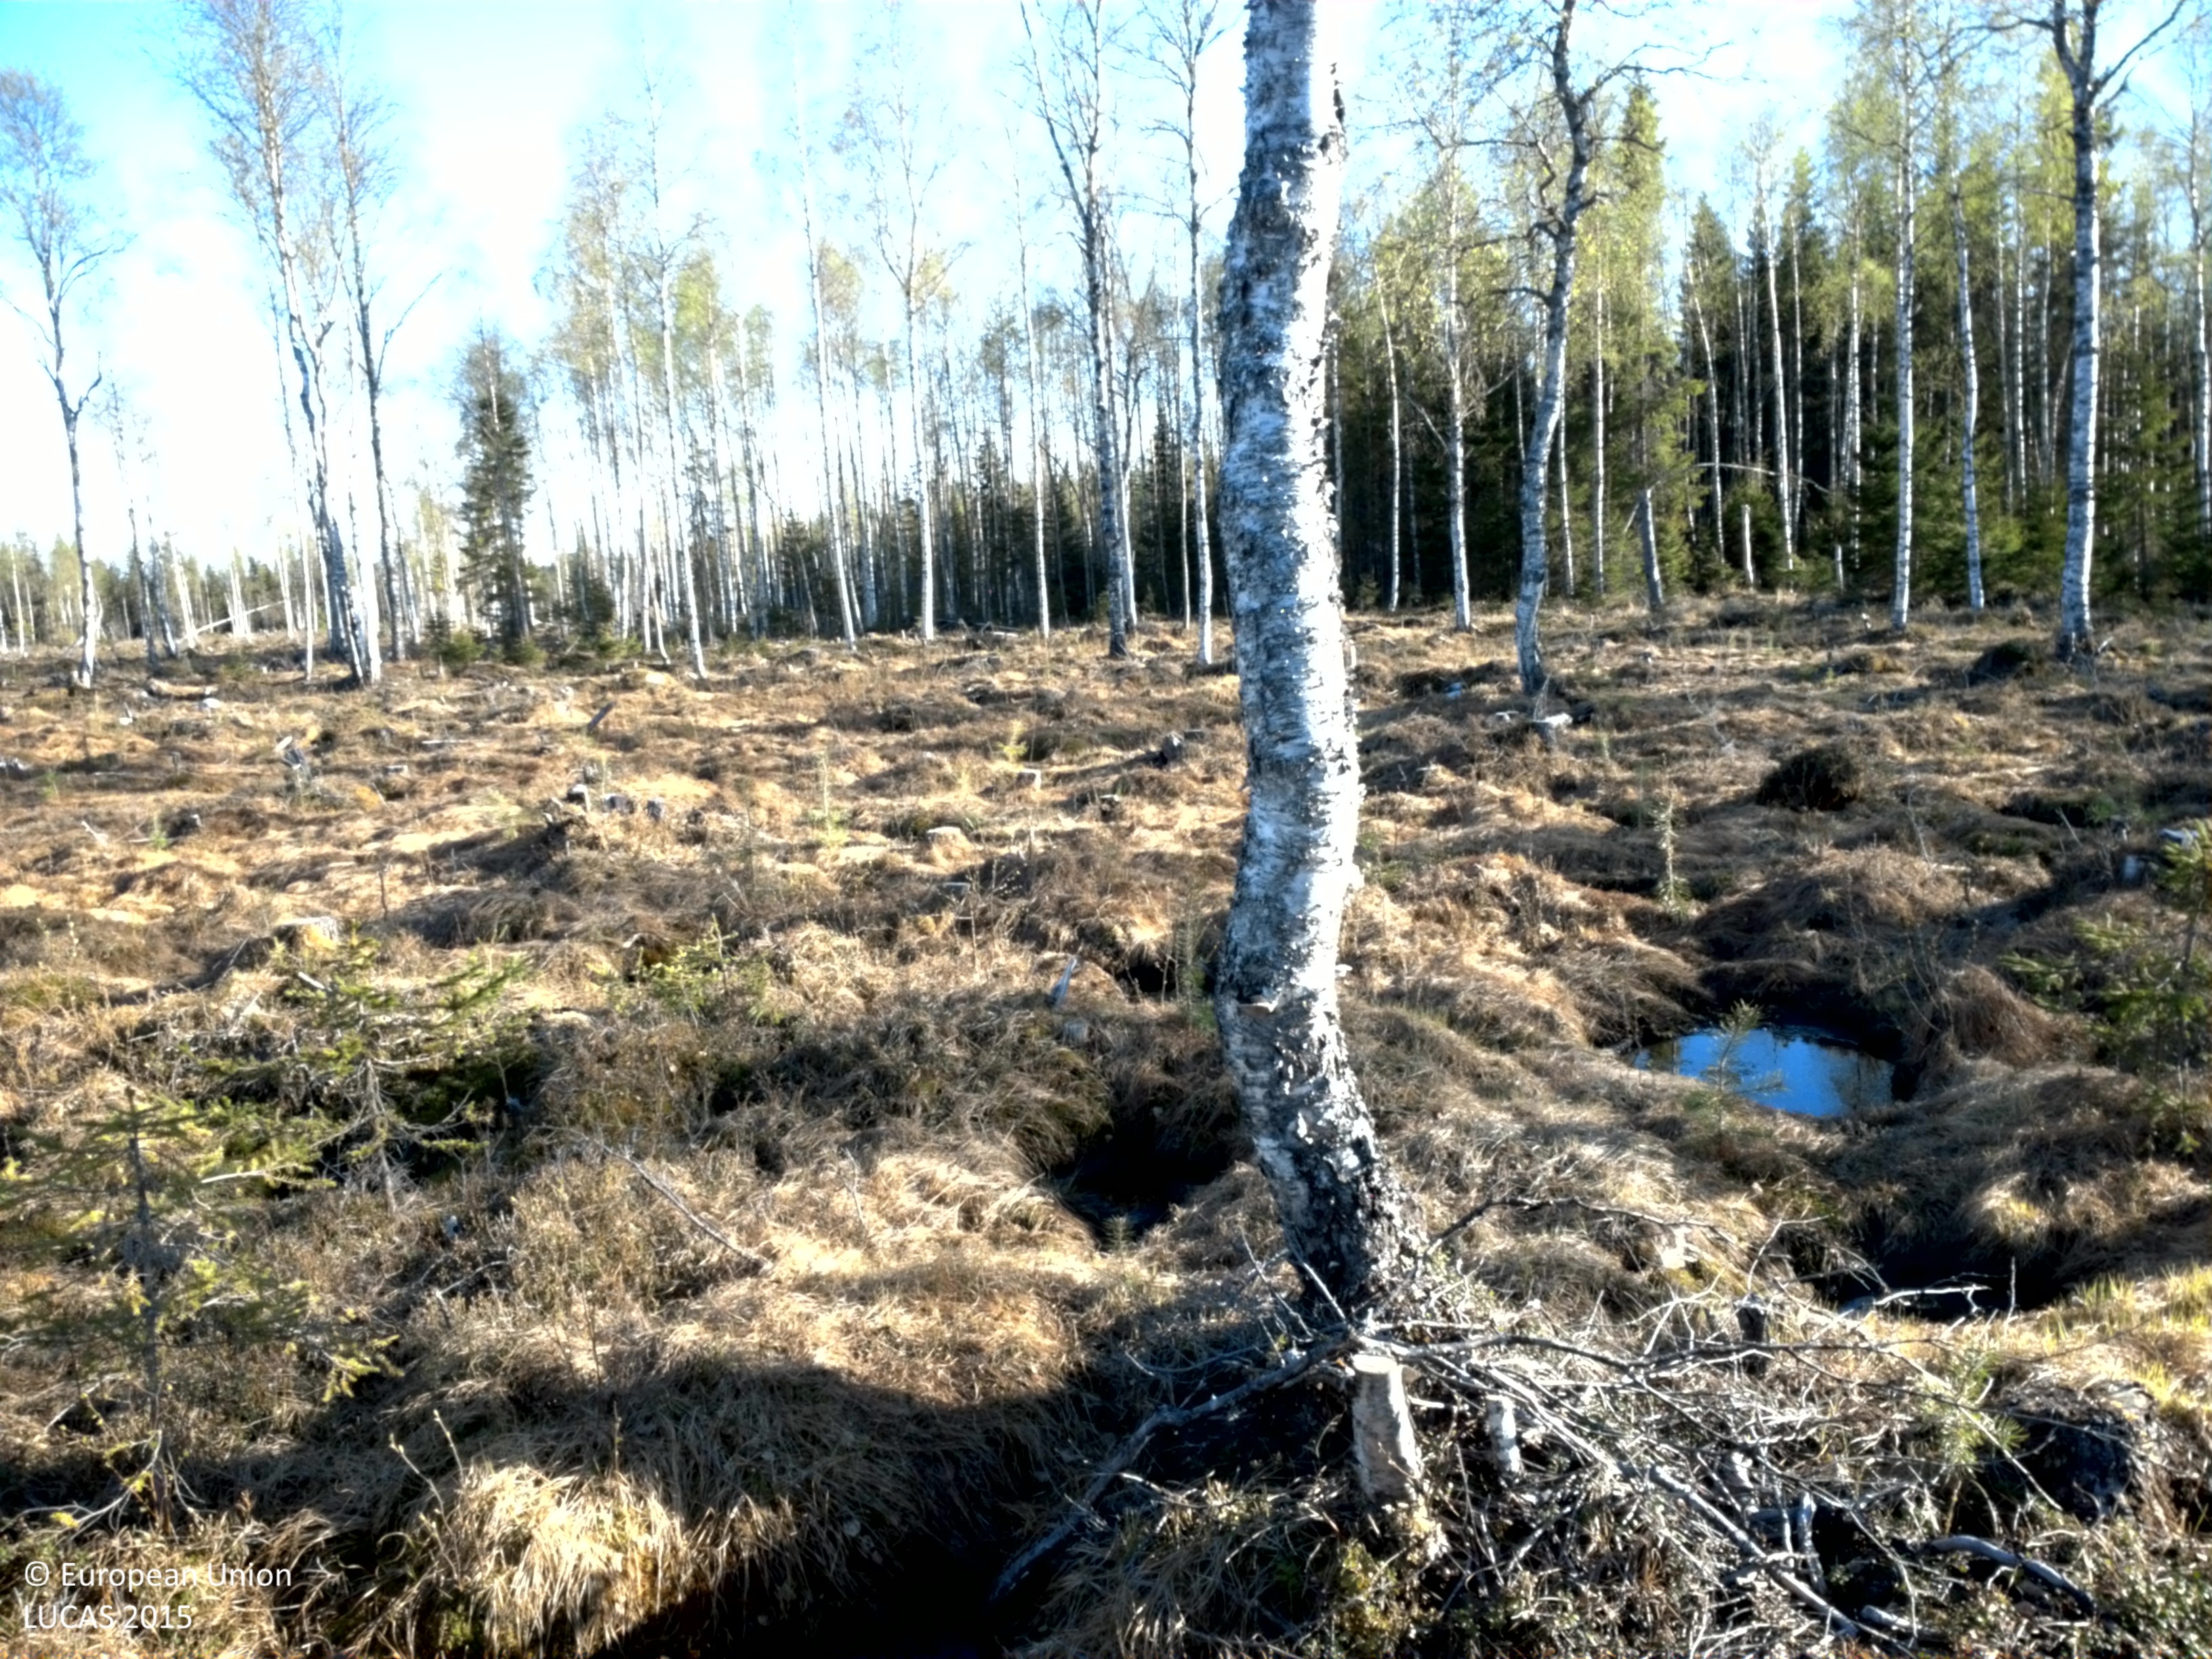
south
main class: Shrubland
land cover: Shrubland with sparse tree cover
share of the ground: 50 - 75 %
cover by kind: shrubs 65 %, herbaceous plants 30 %, broadleaved forest trees 5 %
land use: Forestry
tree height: > 5 m
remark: Clear cut
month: May
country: SE
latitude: 66.0530
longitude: 23.3907
